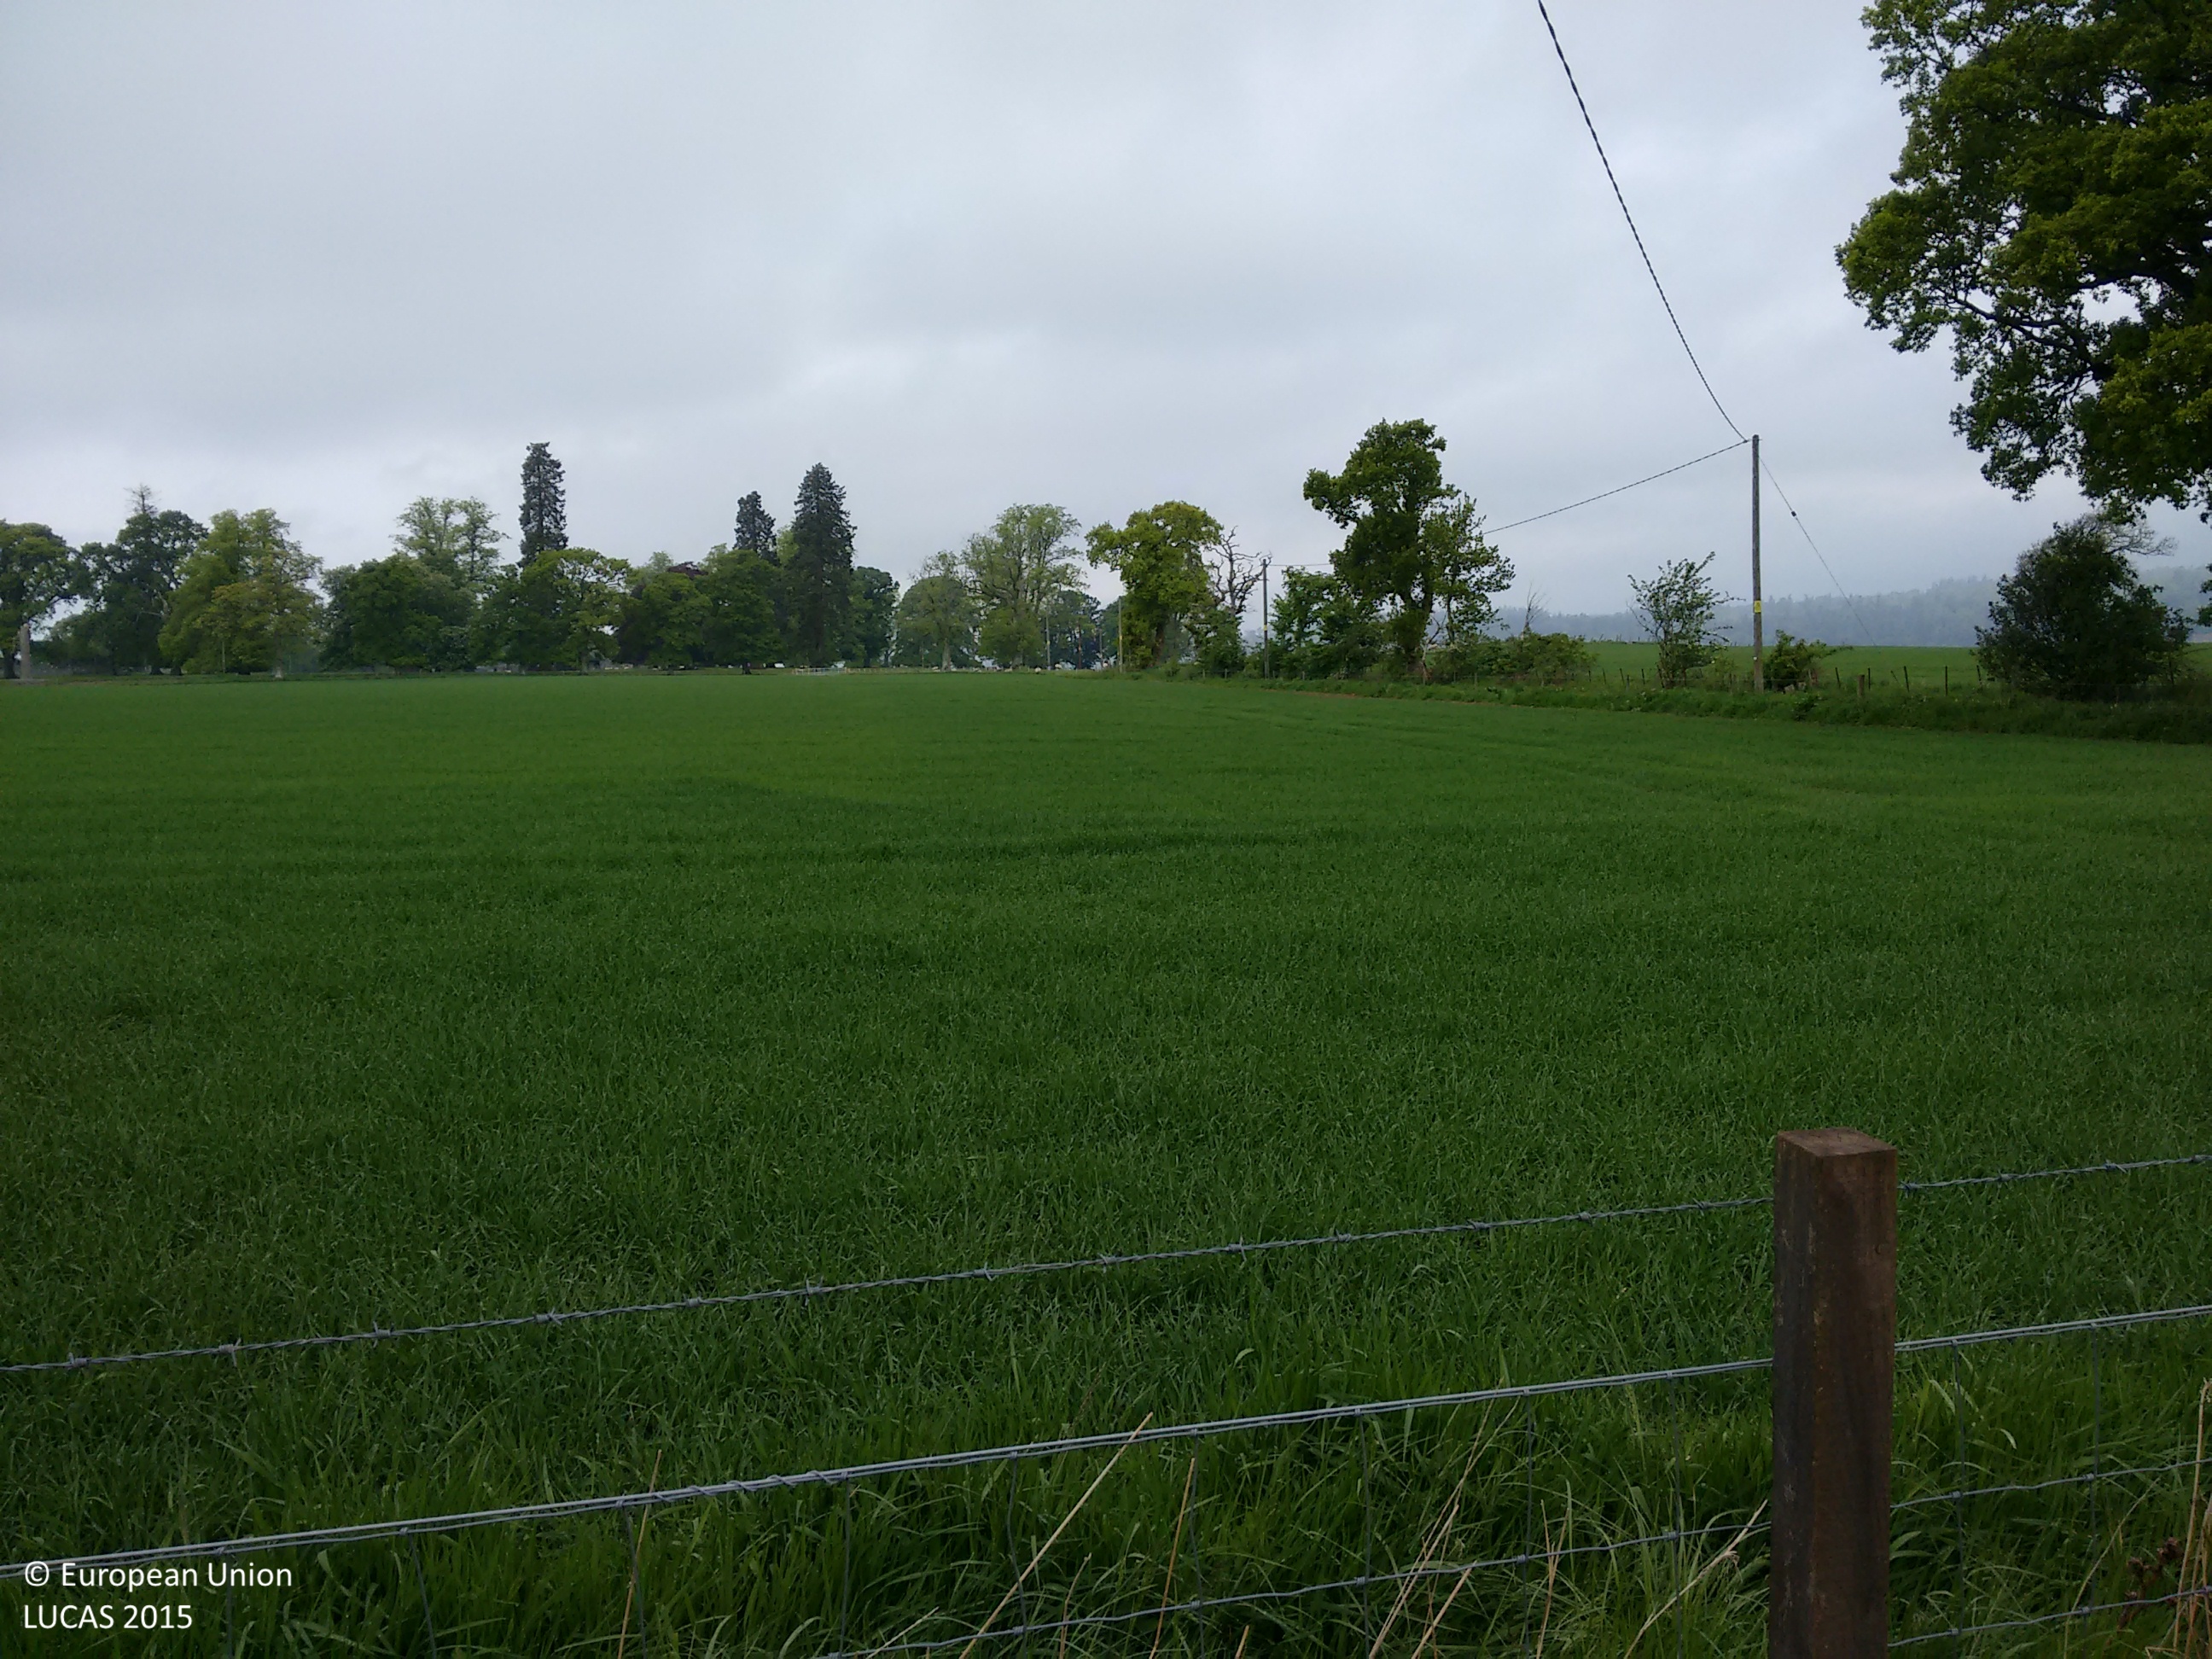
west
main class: Grassland
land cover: Grassland without tree/shrub cover
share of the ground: > 75 %
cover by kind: herbaceous plants 100 %
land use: Residential
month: June
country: GB
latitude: 56.3476
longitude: -3.4891
